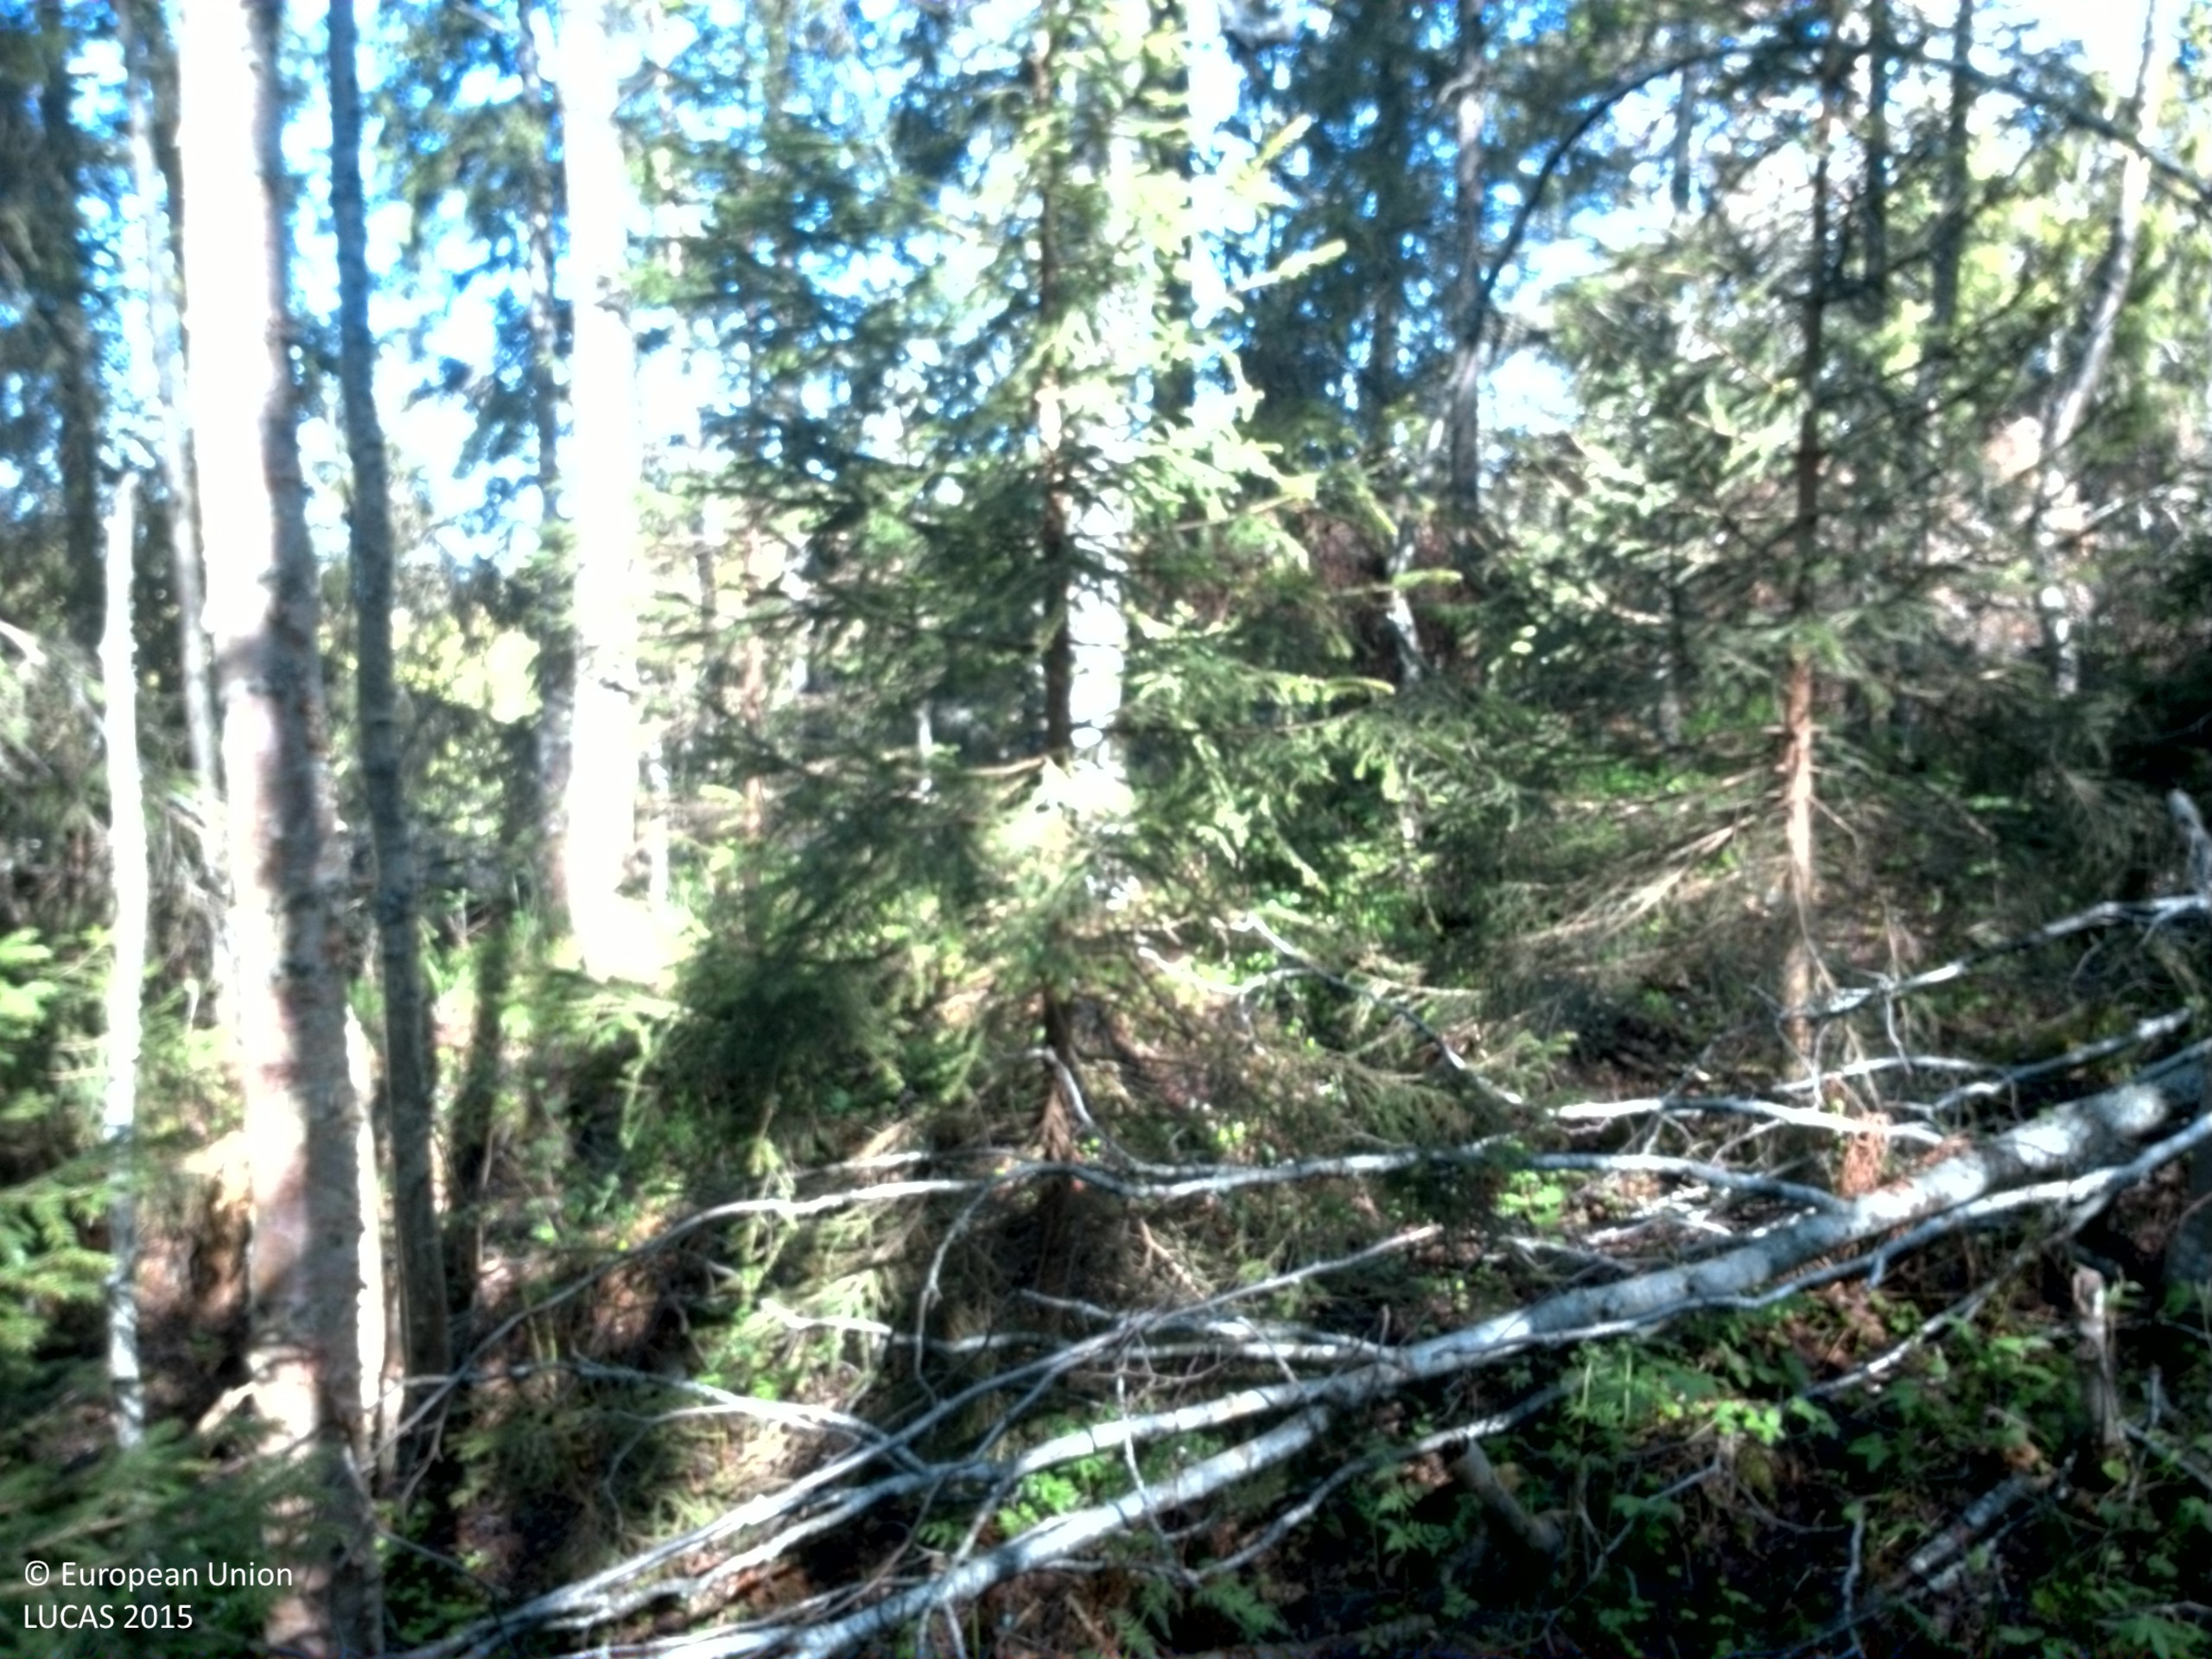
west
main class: Woodland
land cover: Other mixed woodland
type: boreal forest
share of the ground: > 75 %
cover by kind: broadleaved forest trees 60 %, coniferous forest trees 20 %, consolidated bare surface 20 %
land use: Forestry
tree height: > 5 m
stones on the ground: 25 - 50 %
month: May
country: SE
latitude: 62.8061
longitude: 18.1981
